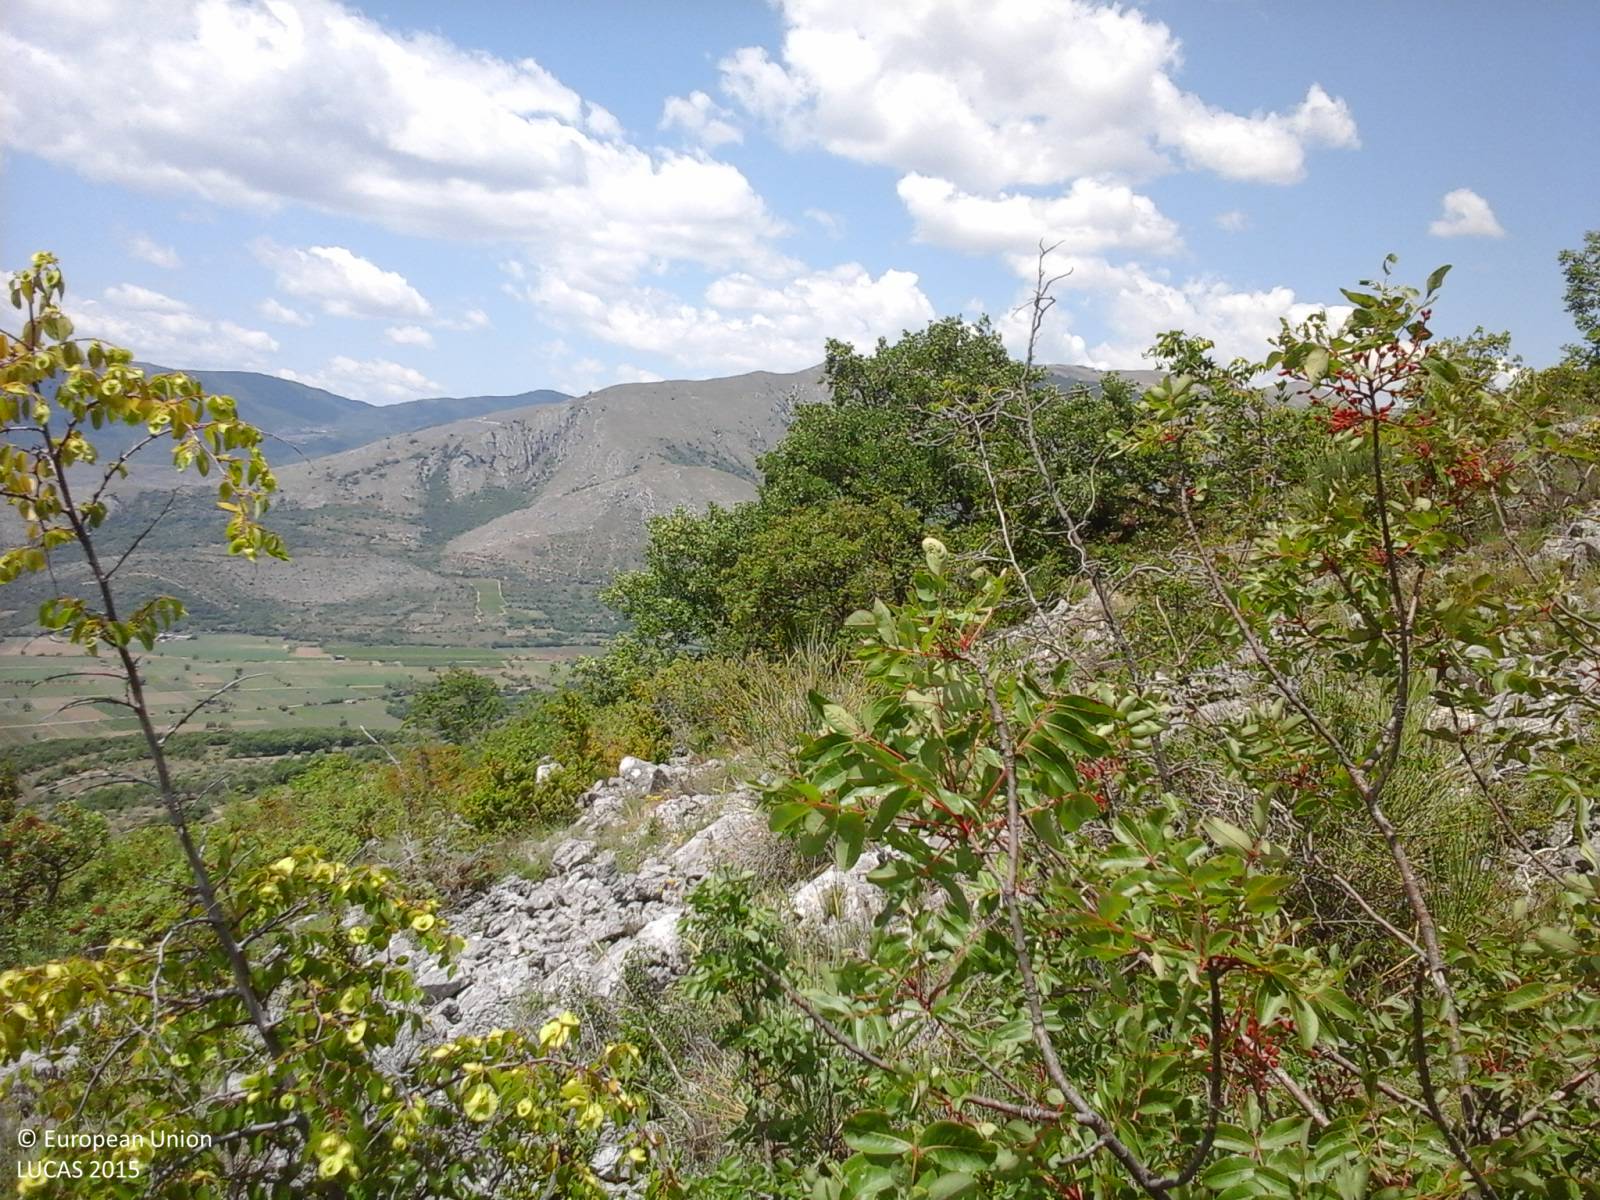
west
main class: Shrubland
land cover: Shrubland without tree cover
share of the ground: 50 - 75 %
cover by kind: shrubs 60 %, unconsolidated bare surface 35 %, herbaceous plants 5 %
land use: Semi-natural and natural areas not in use
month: June
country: IT
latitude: 42.3121
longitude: 13.7854
